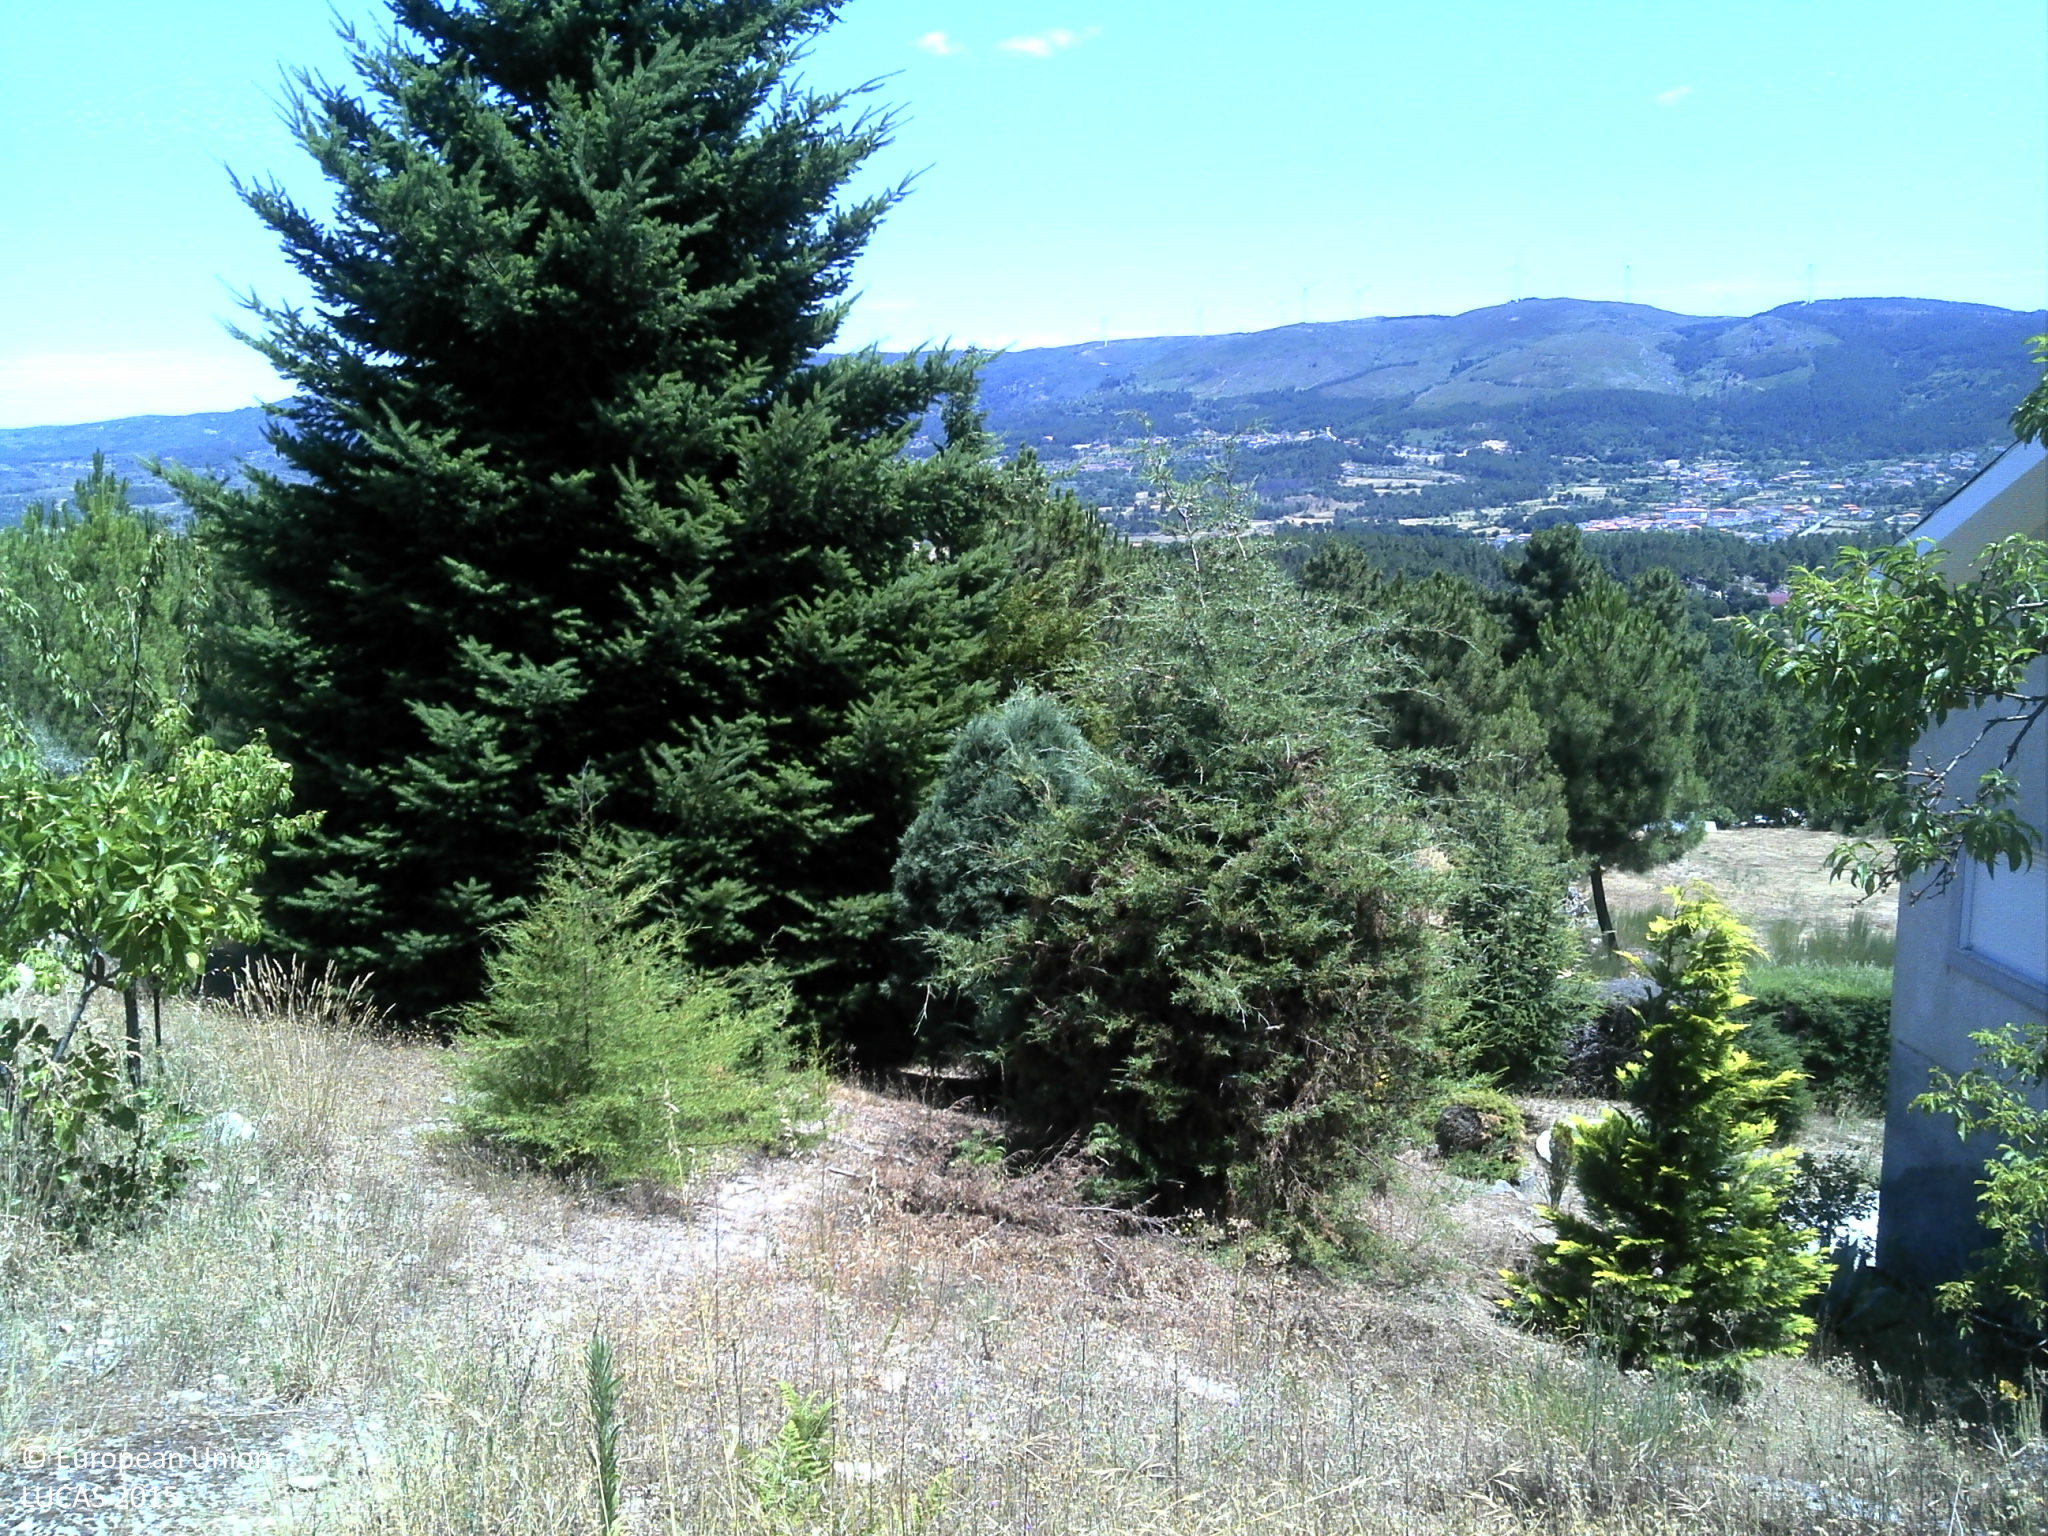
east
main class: Grassland
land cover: Grassland with sparse tree/shrub cover
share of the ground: 50 - 75 %
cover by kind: herbaceous plants 40 %, consolidated bare surface 20 %, unconsolidated bare surface 15 %, shrubs 10 %, coniferous forest trees 5 %
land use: Abandoned areas
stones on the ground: 25 - 50 %
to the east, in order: Grassland with sparse tree/shrub cover; Other mixed woodland; Grass margins; Paved roads, cycling and walking lanes; Shrubland with sparse tree cover; Pine dominated coniferous woodland; Tracks; Pine dominated coniferous woodland; Dry stone walls; Tracks; Pine dominated coniferous woodland; Fences; Tracks; Vineyards; Fences; Grassland without tree/shrub cover
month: July
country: PT
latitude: 41.5552
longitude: -7.6243
